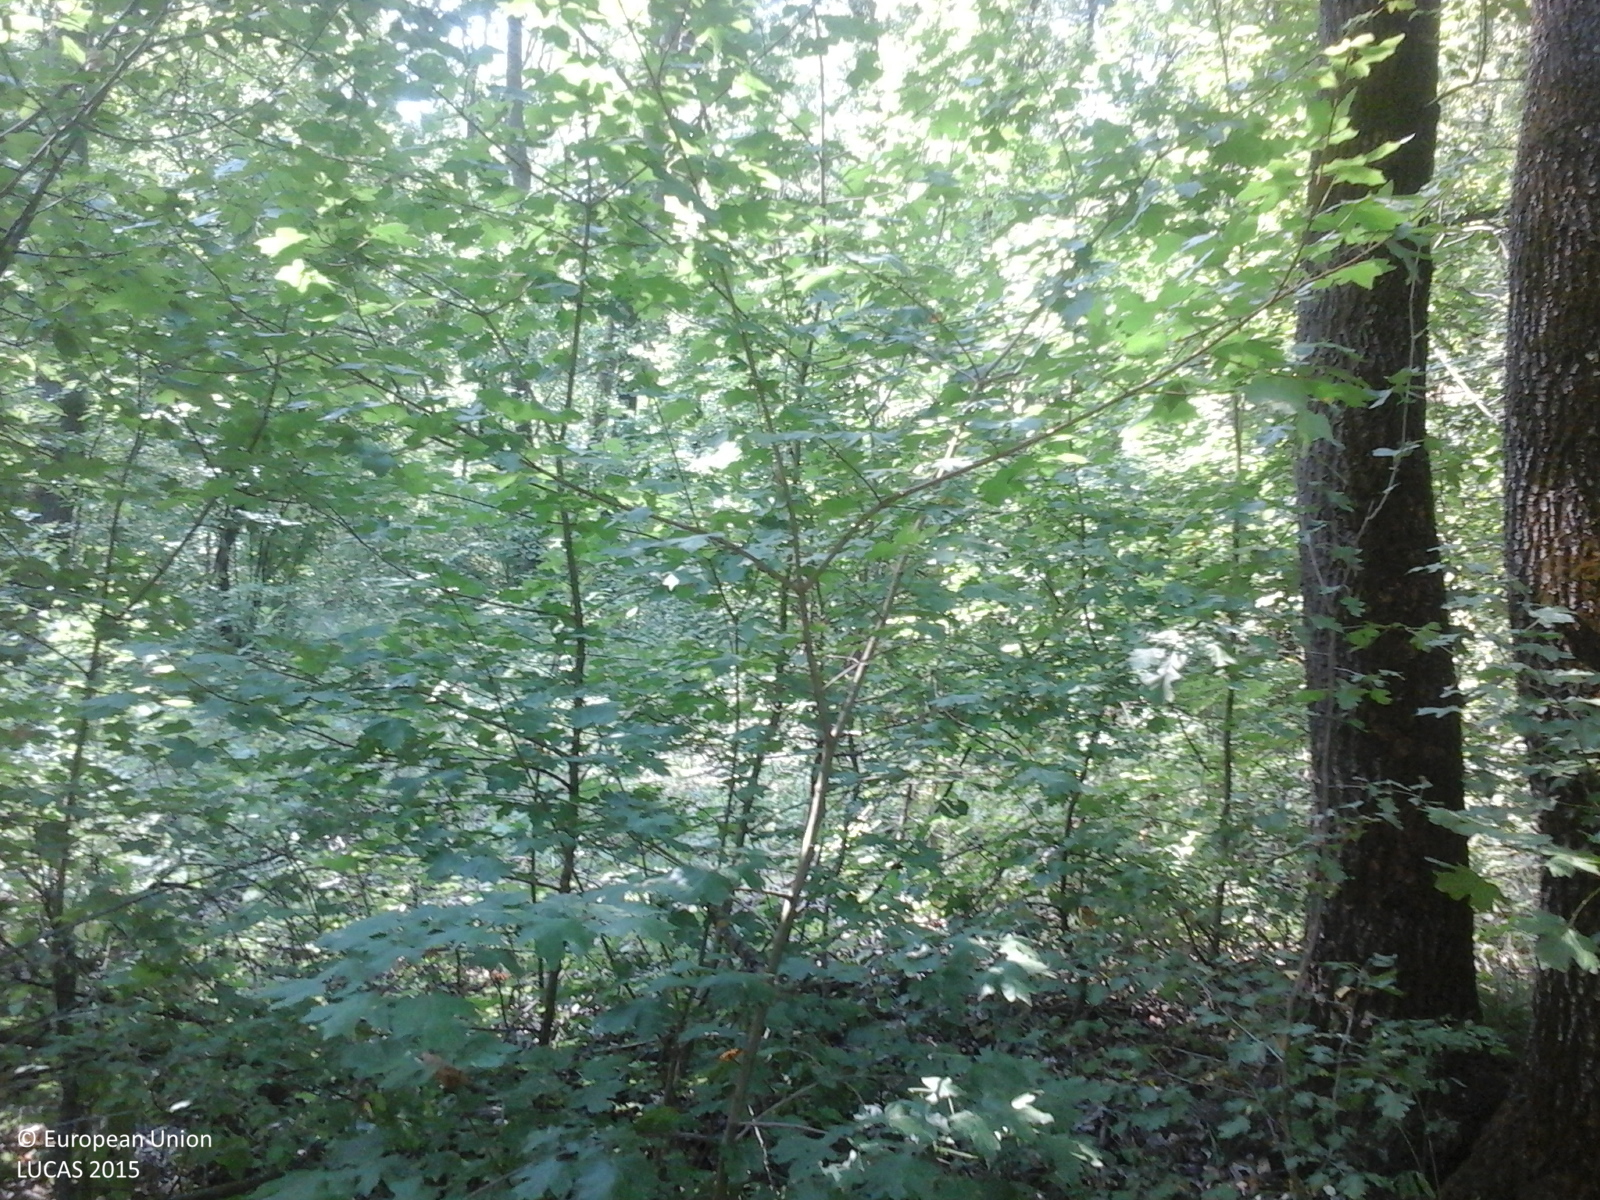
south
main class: Woodland
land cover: Broadleaved woodland
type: acidophilous oak and oak-birch forest
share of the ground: > 75 %
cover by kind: broadleaved forest trees 100 %
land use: Forestry
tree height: > 5 m
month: August
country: RO
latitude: 45.6896
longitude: 27.4770
